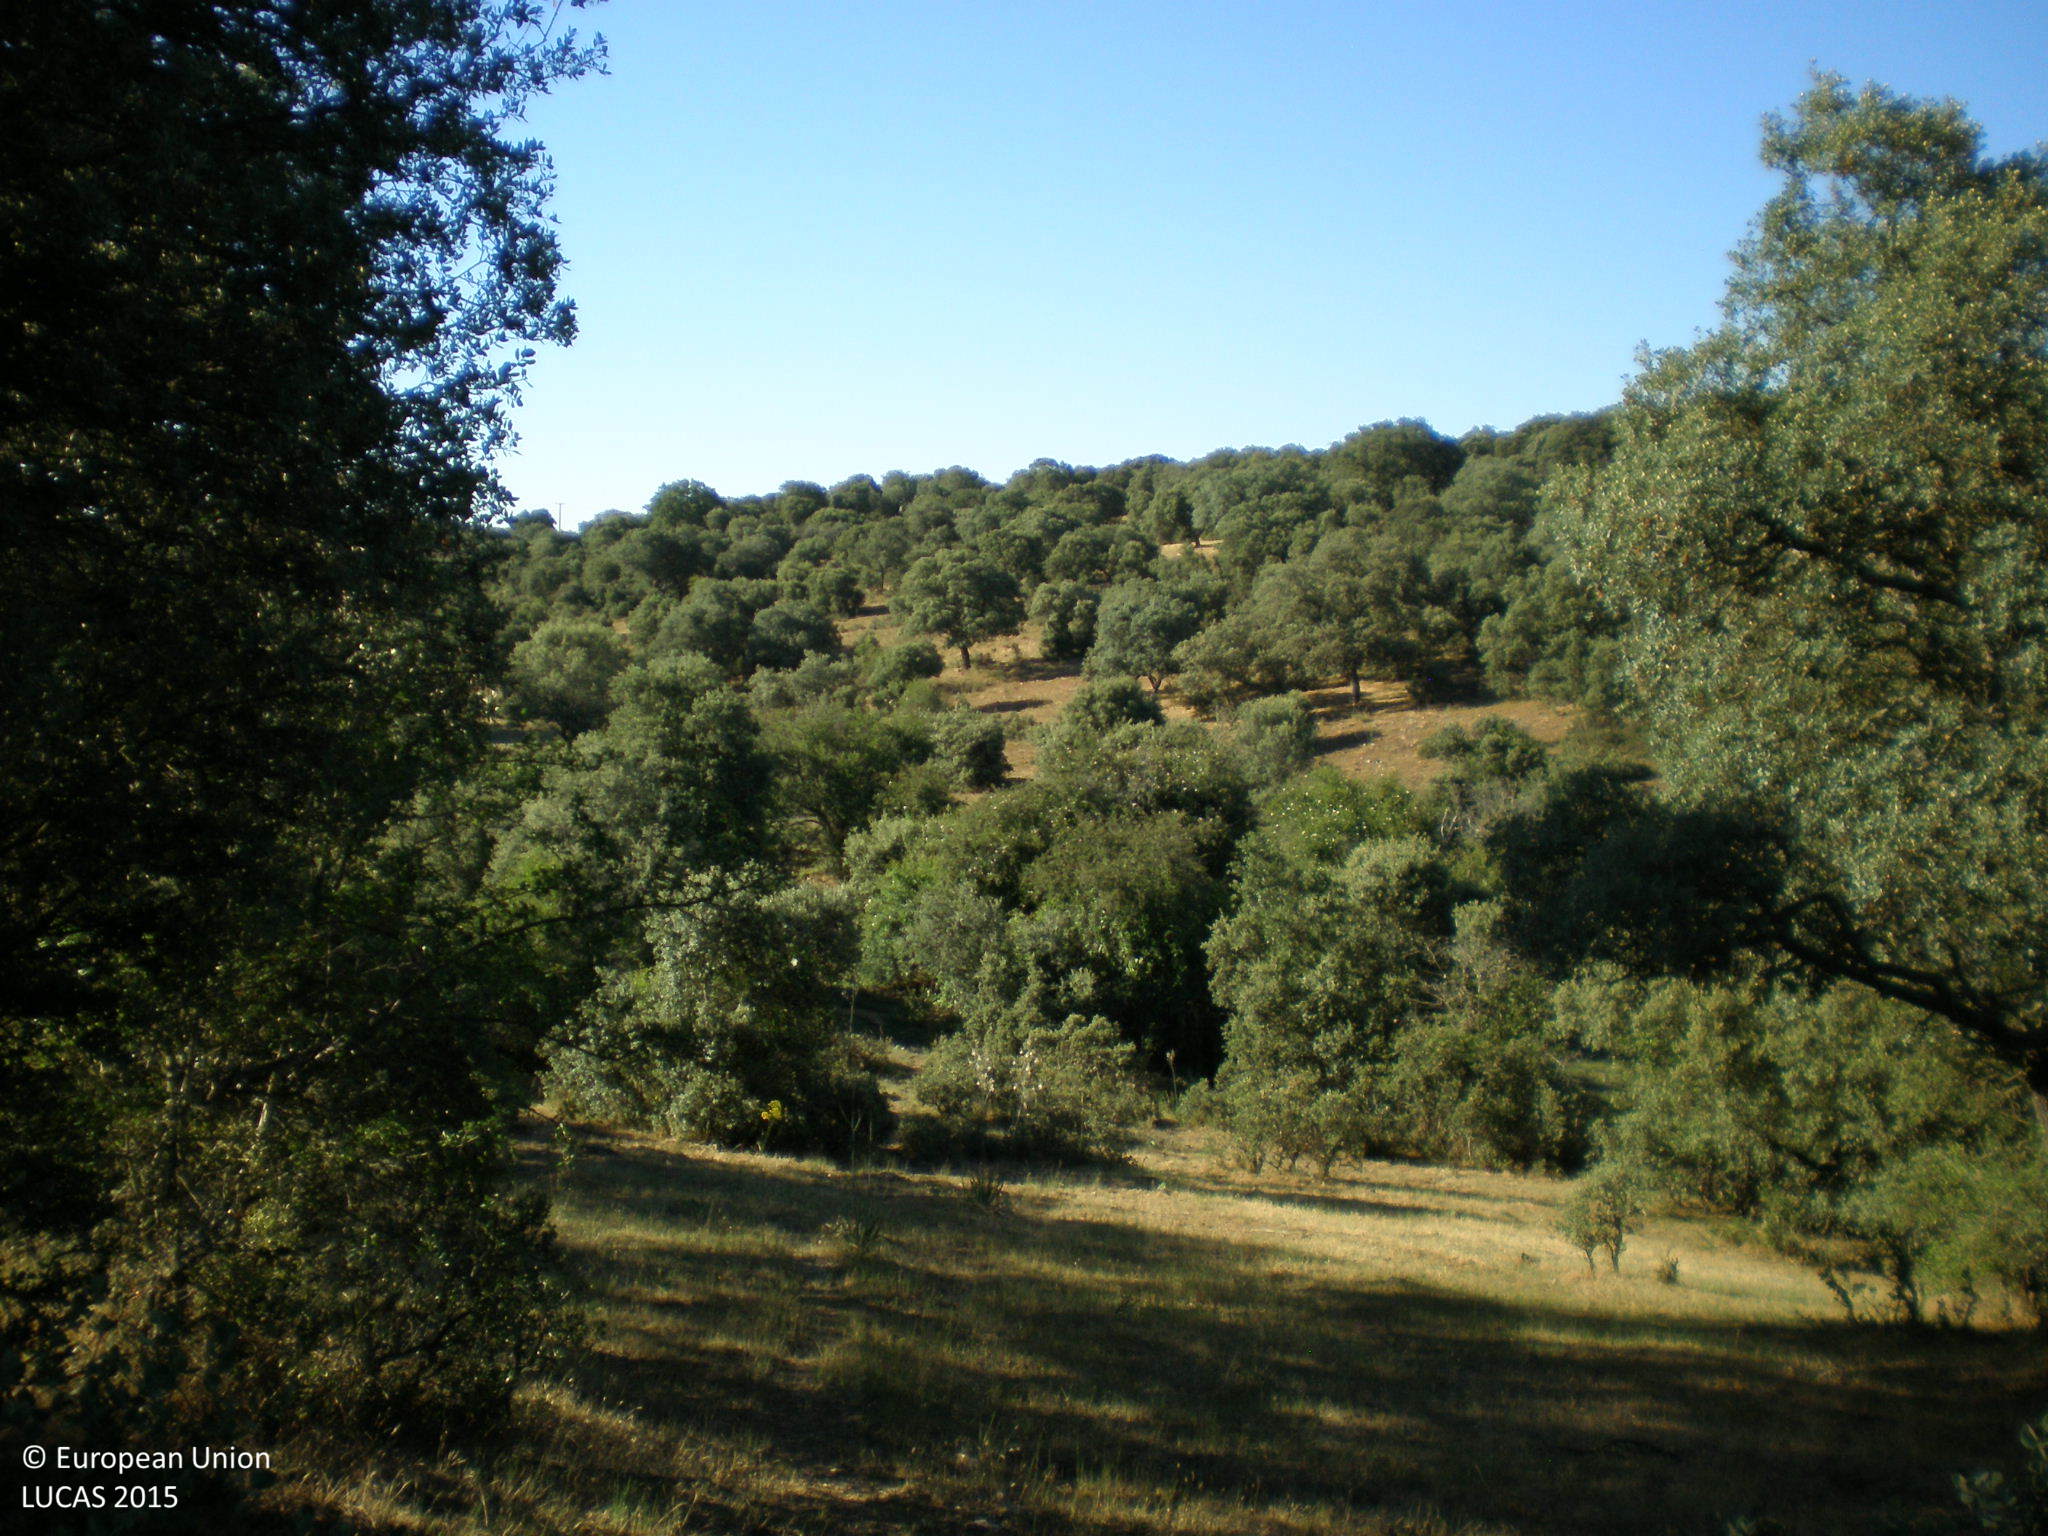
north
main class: Woodland
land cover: Broadleaved woodland
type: broadleaved evergreen forest
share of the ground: 50 - 75 %
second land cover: Grassland without tree/shrub cover
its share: 25 - 50 %
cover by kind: broadleaved forest trees 55 %, herbaceous plants 45 %
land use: Forestry
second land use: Agriculture (excluding fallow land and kitchen gardens)
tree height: > 5 m
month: June
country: ES
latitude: 40.7456
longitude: -5.6715
